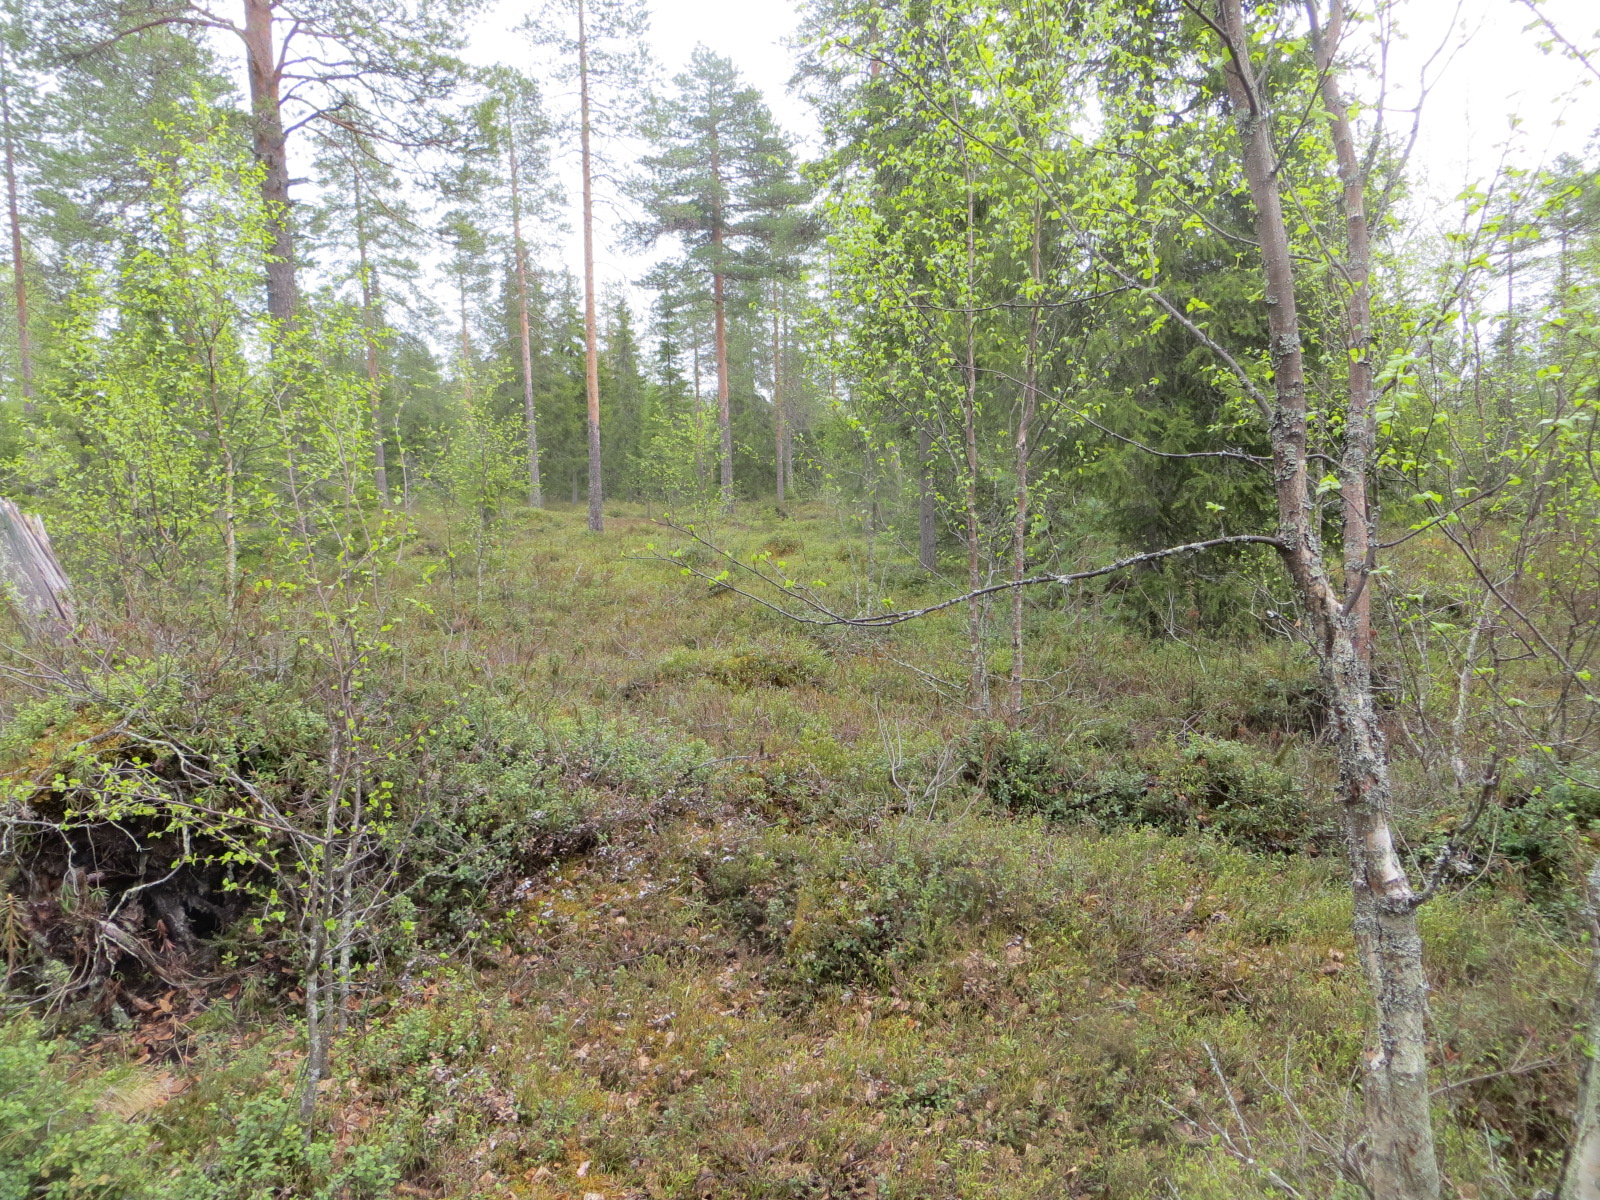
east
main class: Woodland
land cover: Pine dominated mixed woodland
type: boreal forest
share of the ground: 50 - 75 %
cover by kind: coniferous forest trees 35 %, broadleaved forest trees 35 %, shrubs 25 %, lichens and mosses 5 %
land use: Forestry
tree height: > 5 m
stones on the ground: < 10 %
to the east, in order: Pine dominated mixed woodland; Ditches and canals; Pine dominated coniferous woodland; Tracks; Pine dominated coniferous woodland; Tracks
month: June
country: FI
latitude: 66.5447
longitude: 25.8075
